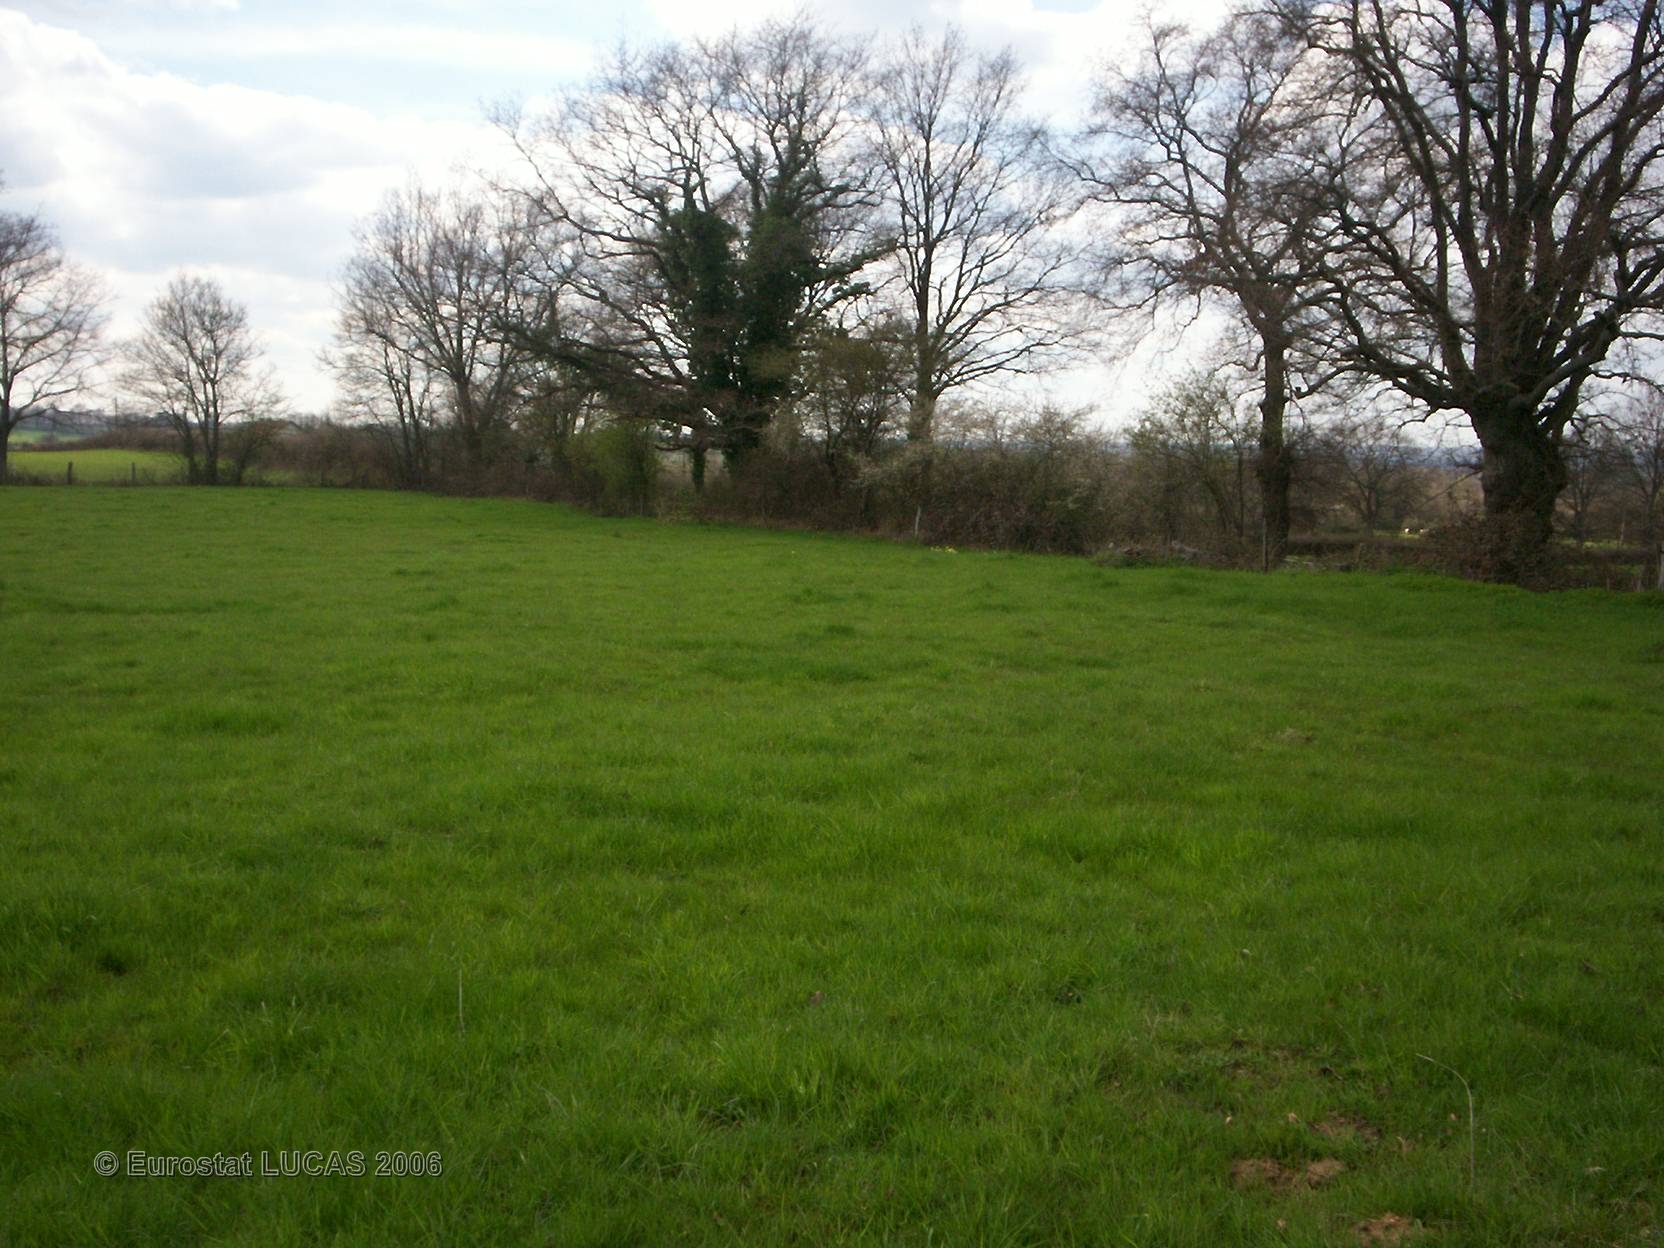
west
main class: Grassland
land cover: Grassland without tree/shrub cover
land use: Agriculture (excluding fallow land and kitchen gardens)
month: April
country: FR
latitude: 46.7802
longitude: 3.1205
